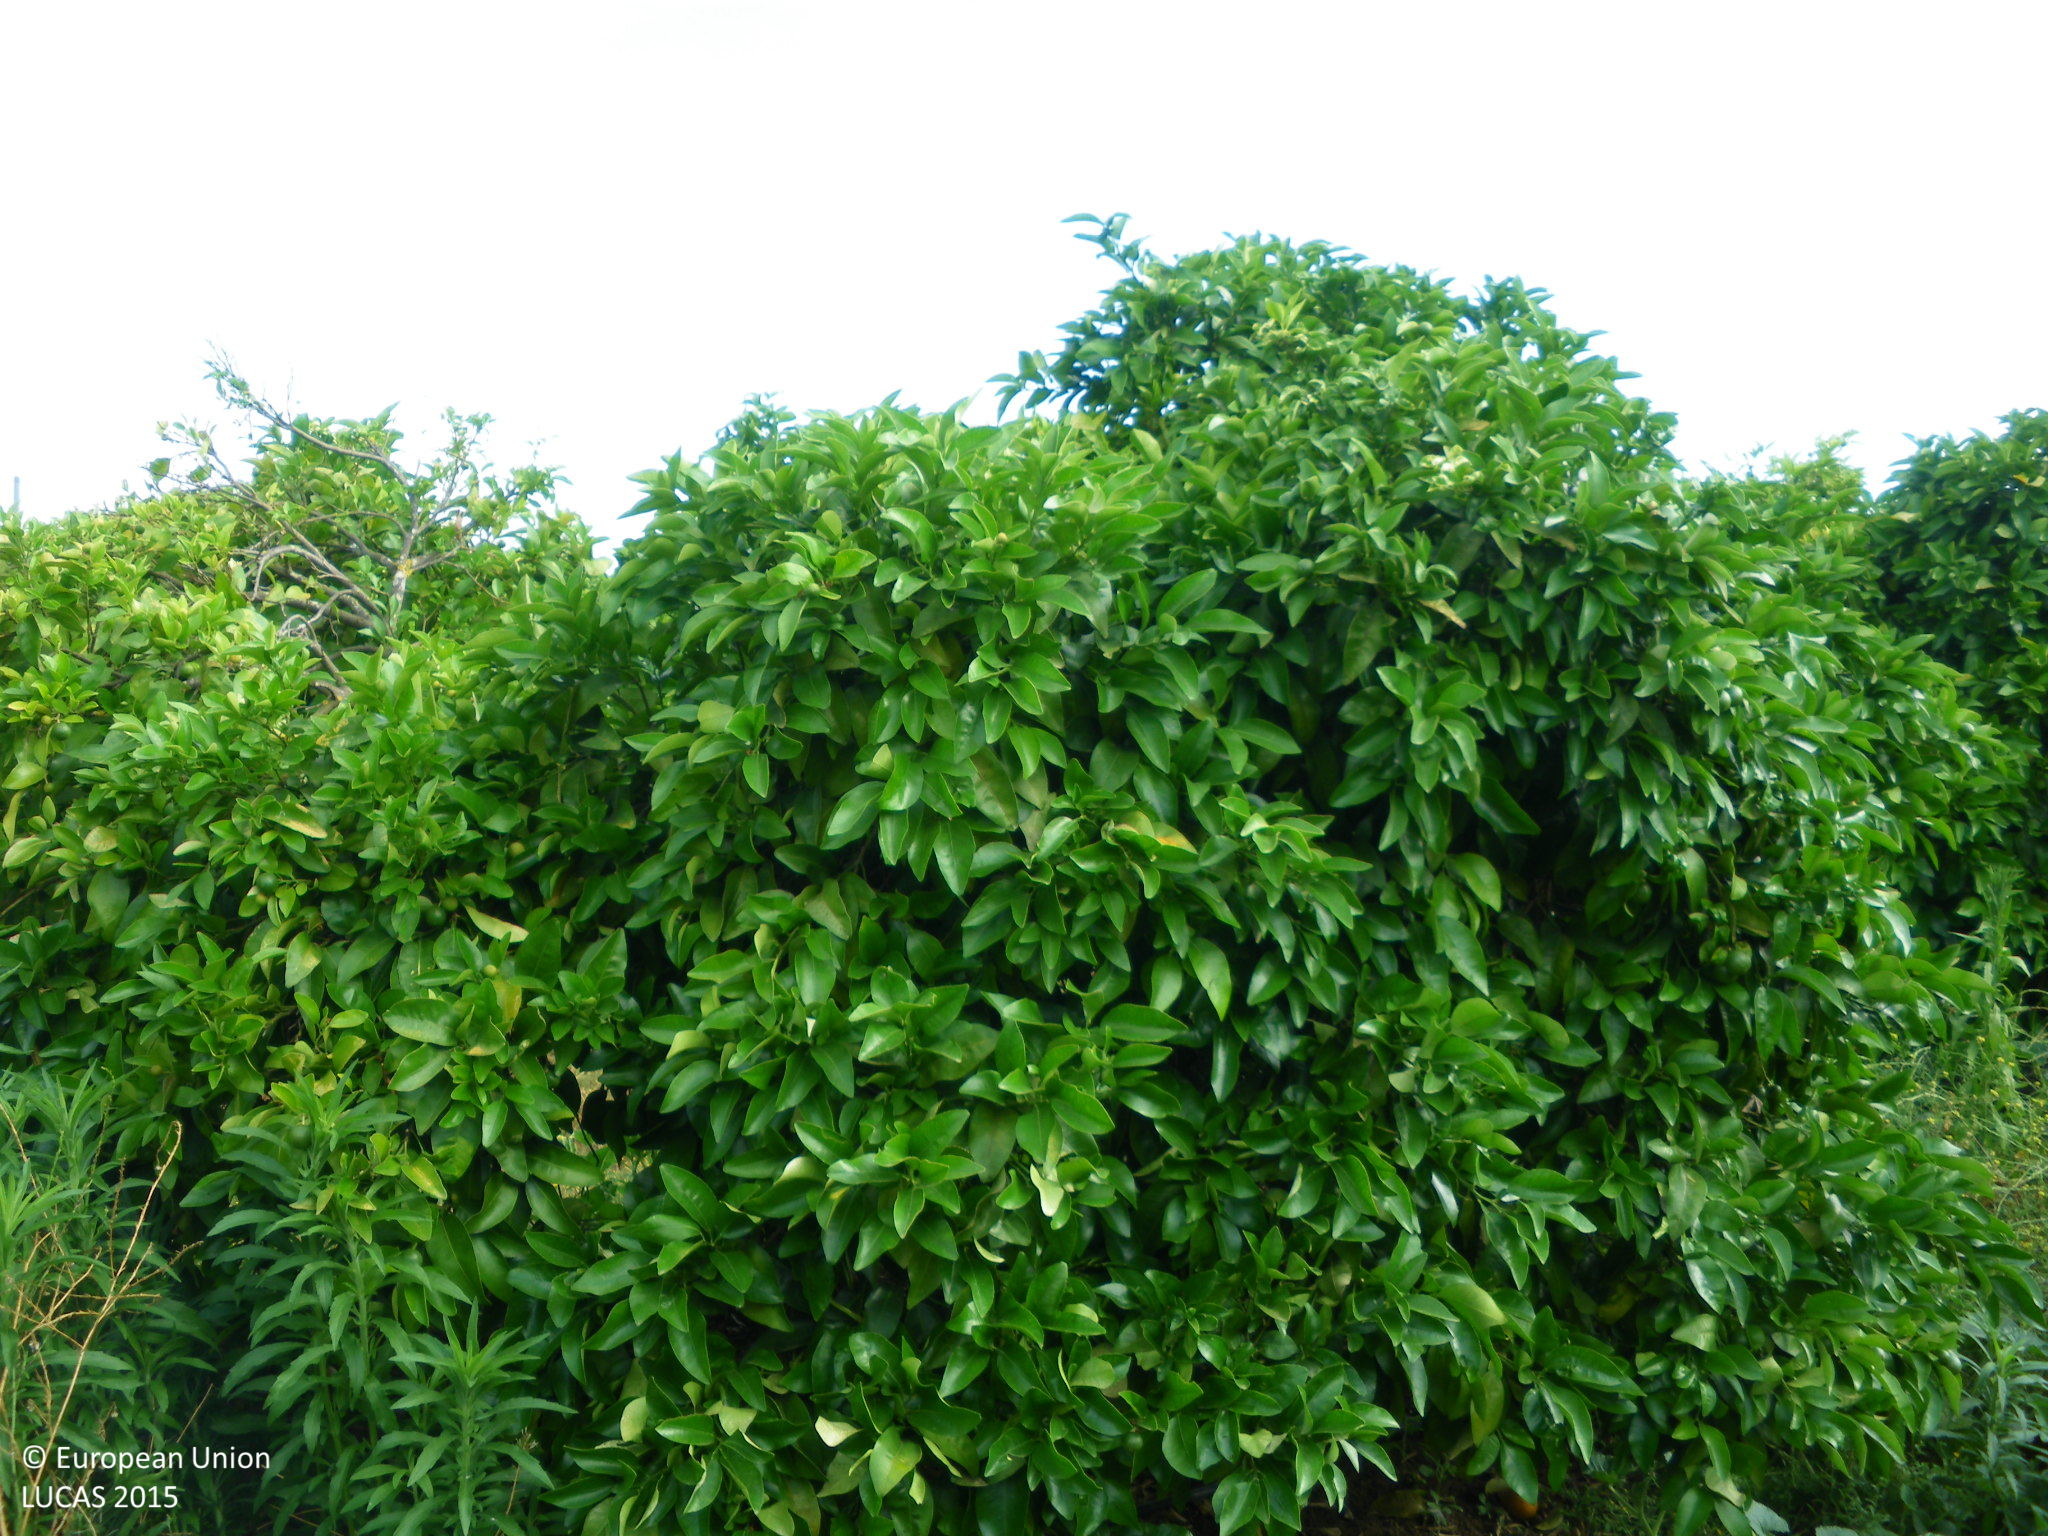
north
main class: Cropland
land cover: Other citrus fruit
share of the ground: 25 - 50 %
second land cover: Spontaneously vegetated surfaces
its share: > 75 %
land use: Agriculture (excluding fallow land and kitchen gardens)
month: June
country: ES
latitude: 36.3094
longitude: -5.8936
